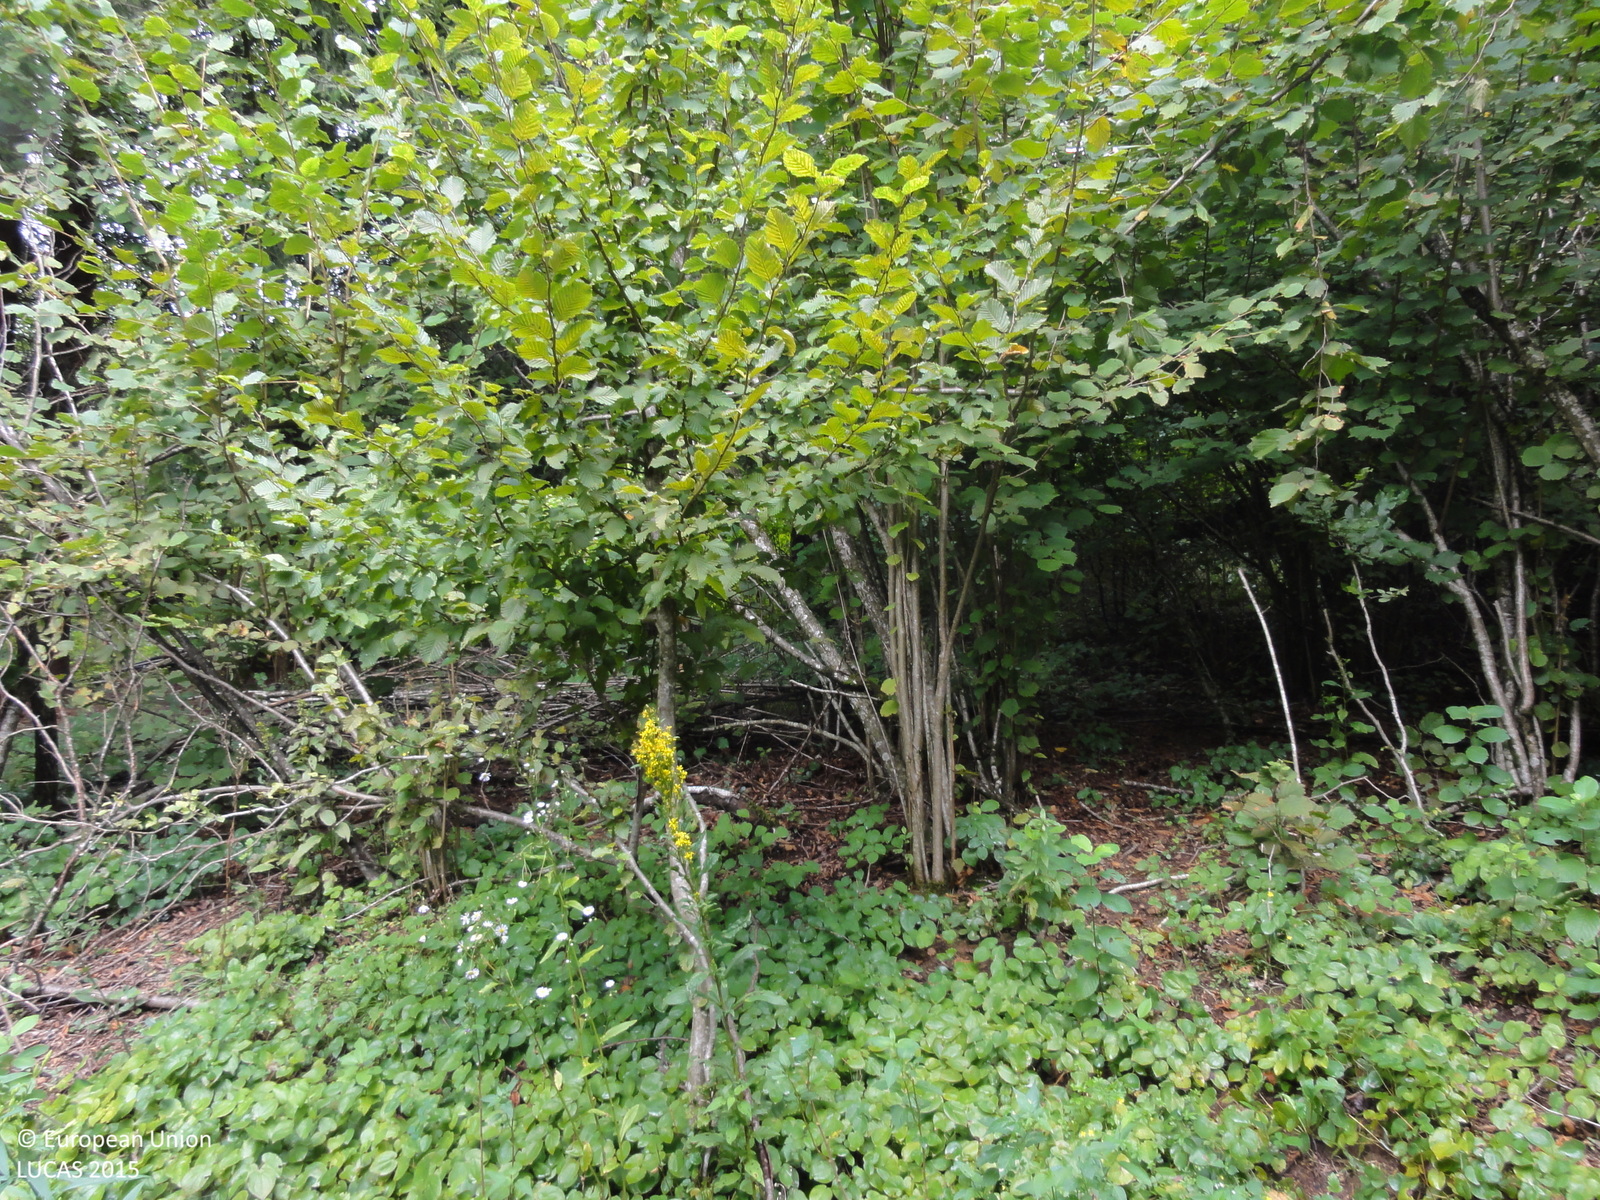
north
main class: Woodland
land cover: Broadleaved woodland
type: beech forest
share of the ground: 25 - 50 %
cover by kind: shrubs 70 %, broadleaved forest trees 30 %
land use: Forestry
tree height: > 5 m
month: August
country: SI
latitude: 45.7448
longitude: 15.0477
